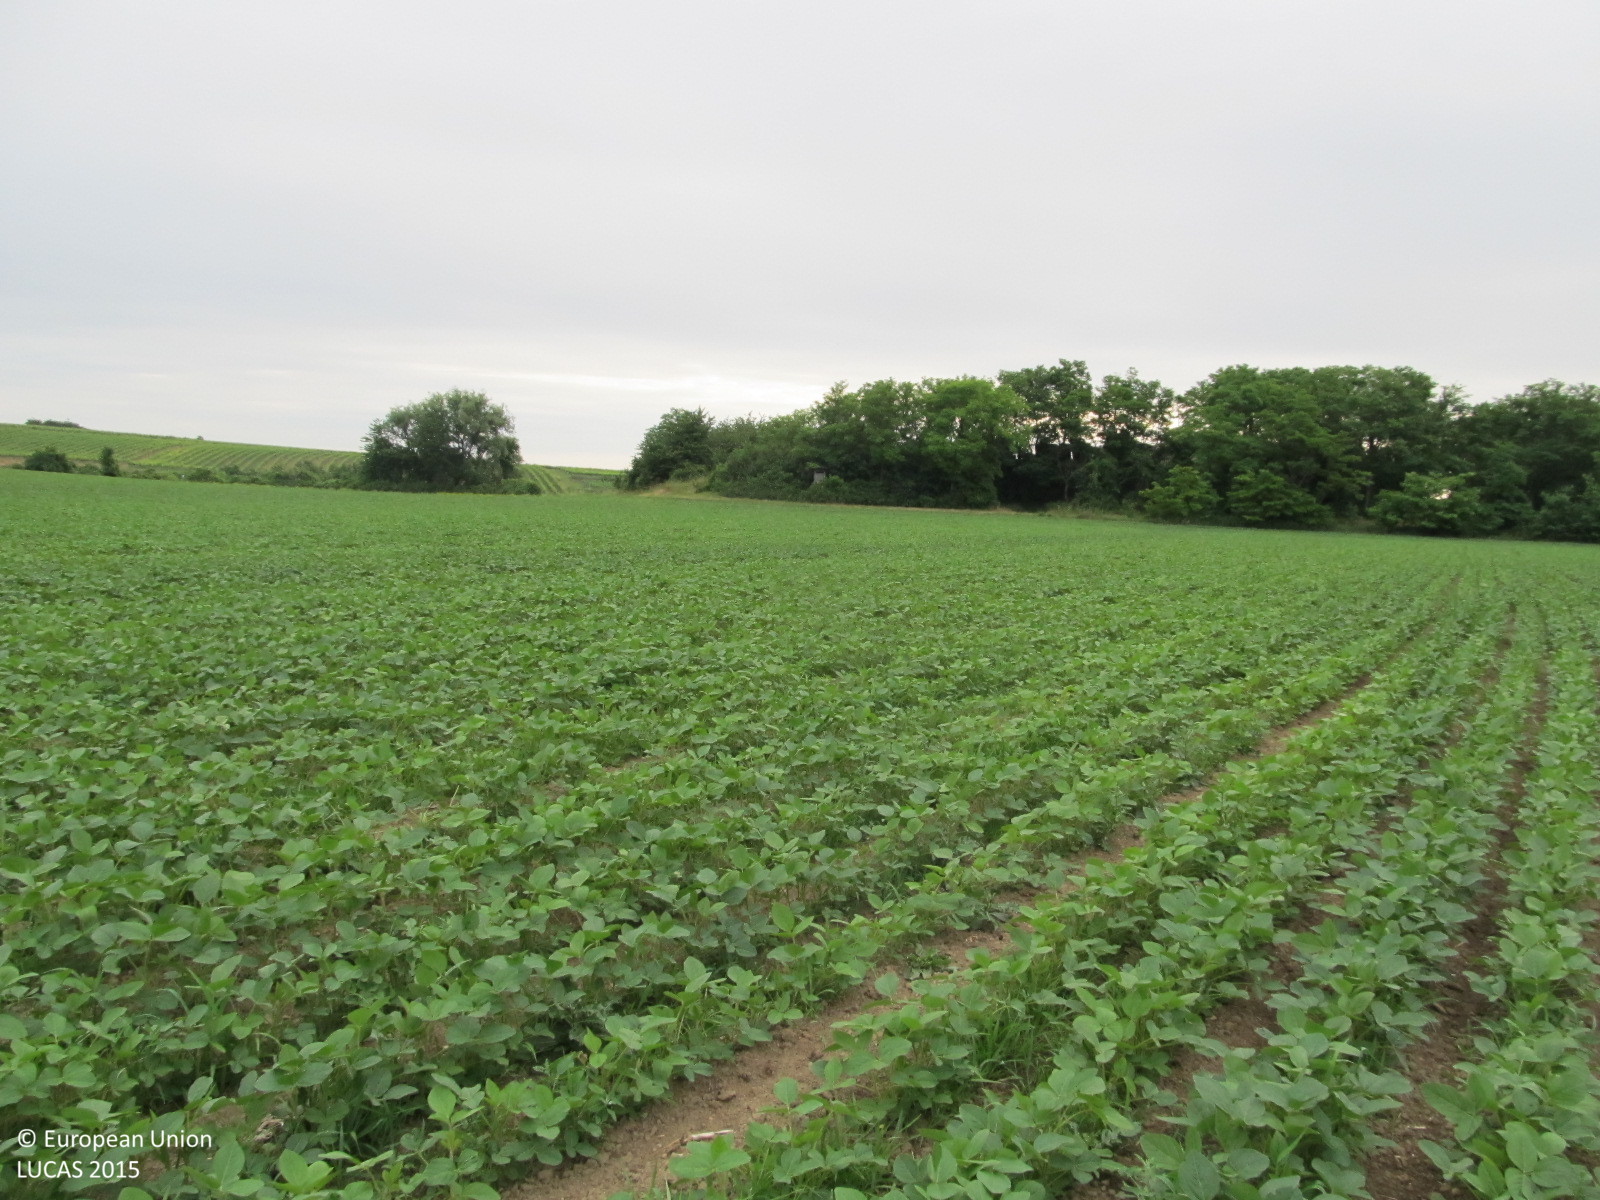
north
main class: Cropland
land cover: Soya
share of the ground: 50 - 75 %
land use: Agriculture (excluding fallow land and kitchen gardens)
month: June
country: AT
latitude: 48.3682
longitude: 15.6319
